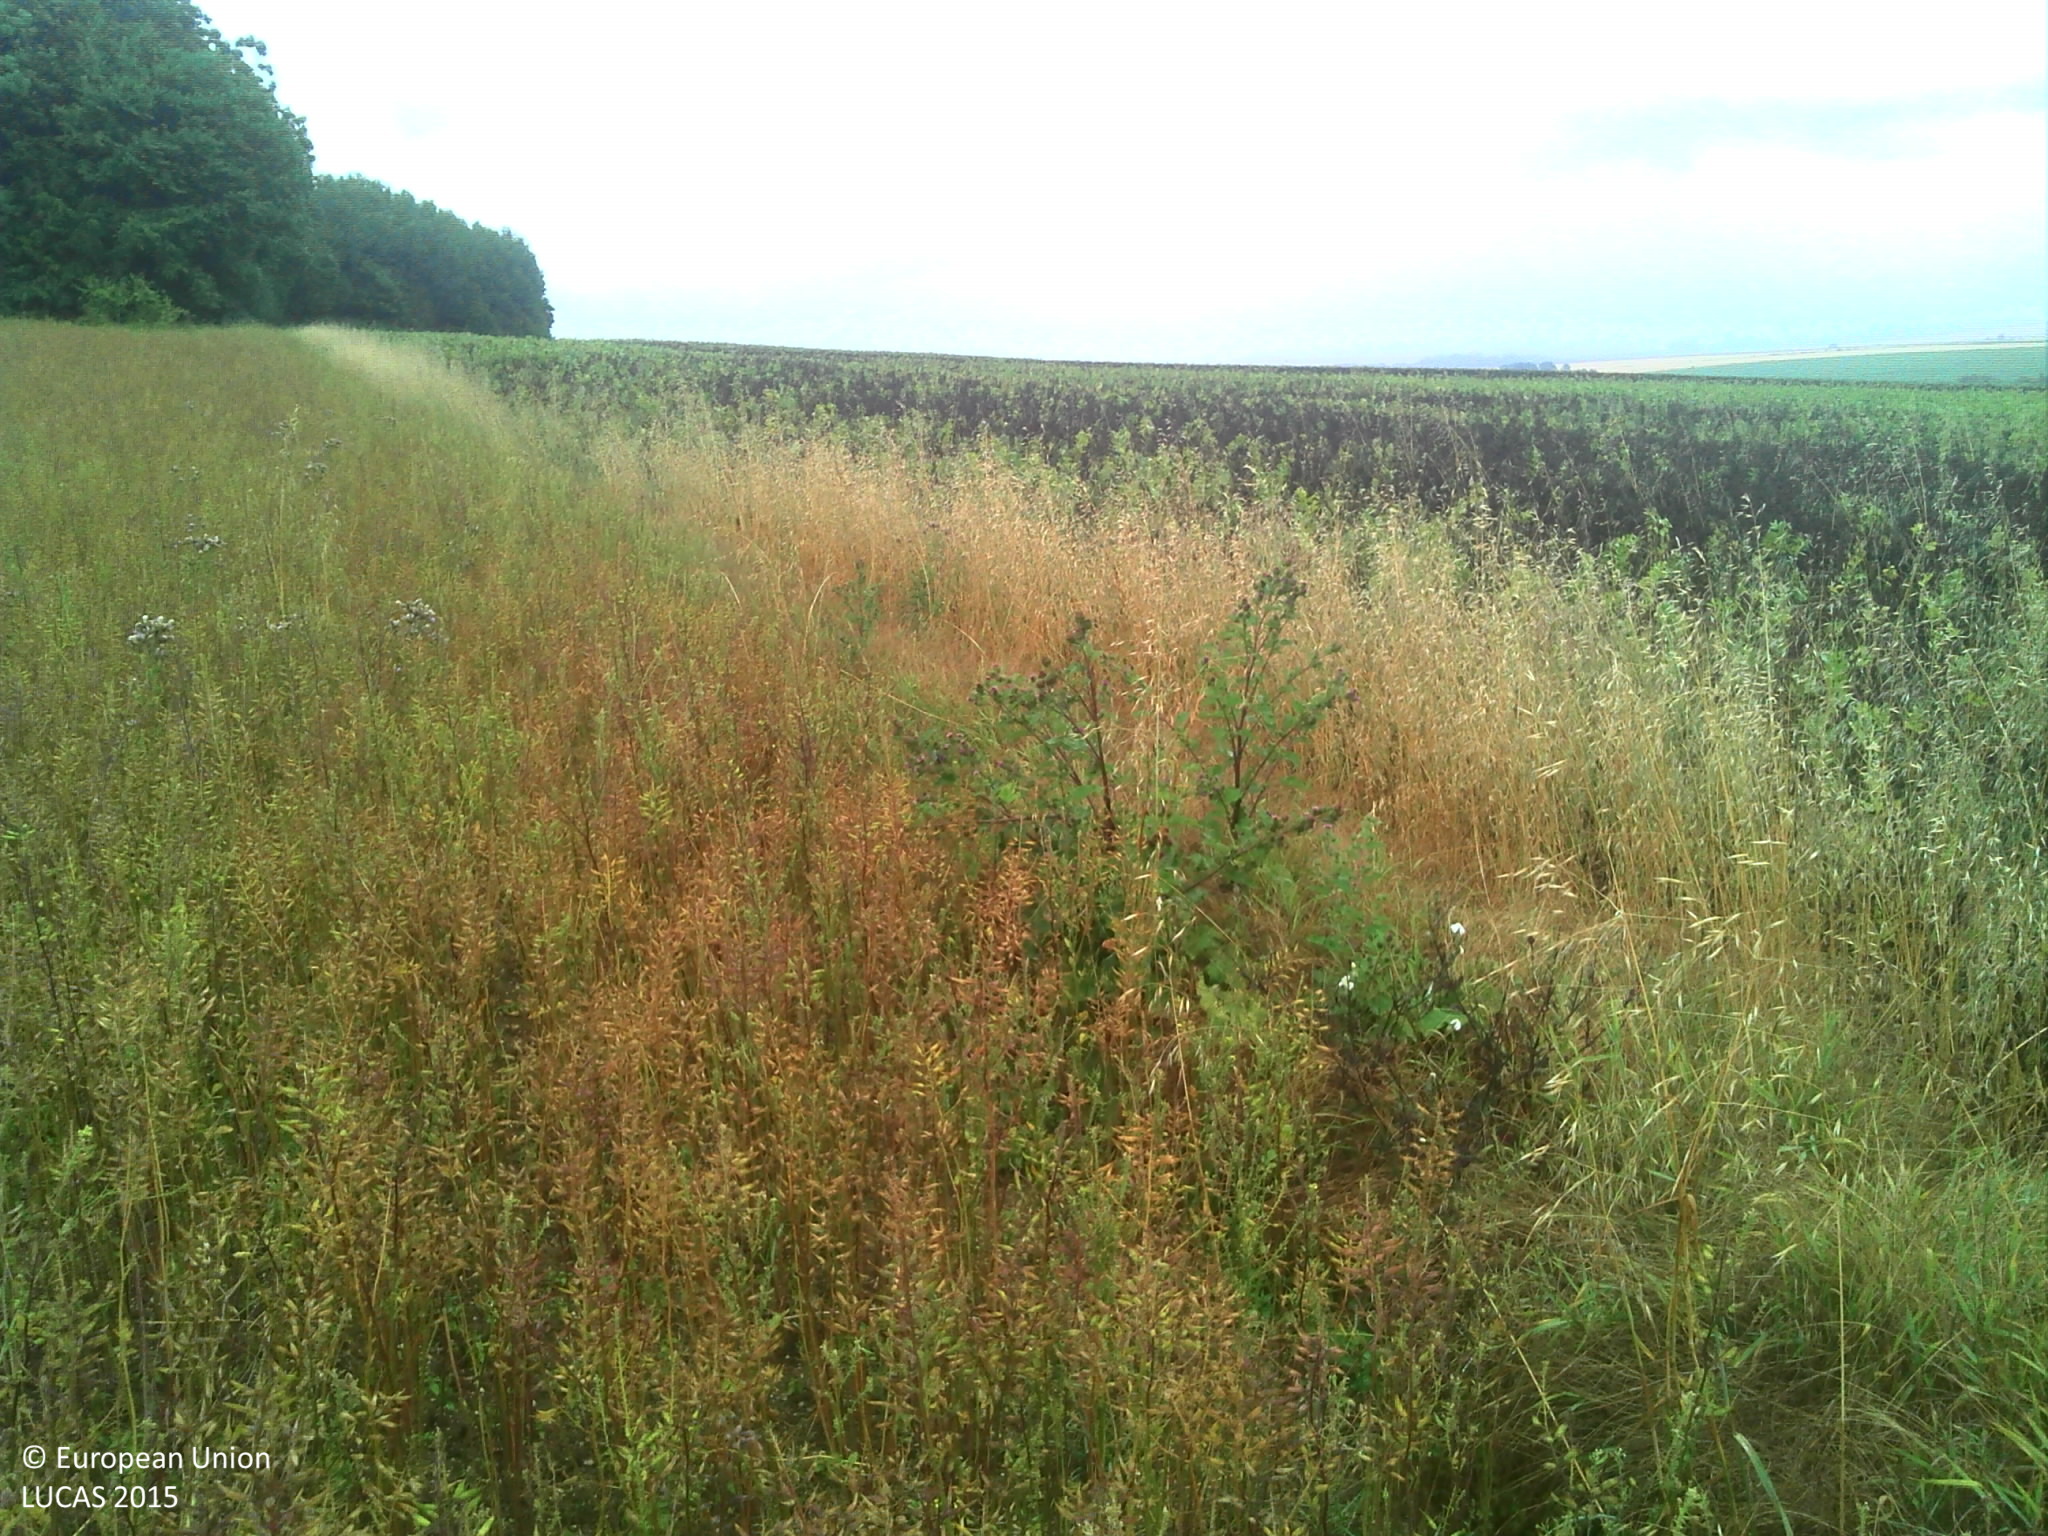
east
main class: Cropland
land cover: Other fibre and oleaginous crops
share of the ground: 50 - 75 %
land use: Agriculture (excluding fallow land and kitchen gardens)
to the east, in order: Other fibre and oleaginous crops; Grass margins; Dry pulses
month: July
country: FR
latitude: 49.6651
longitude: 3.6617
